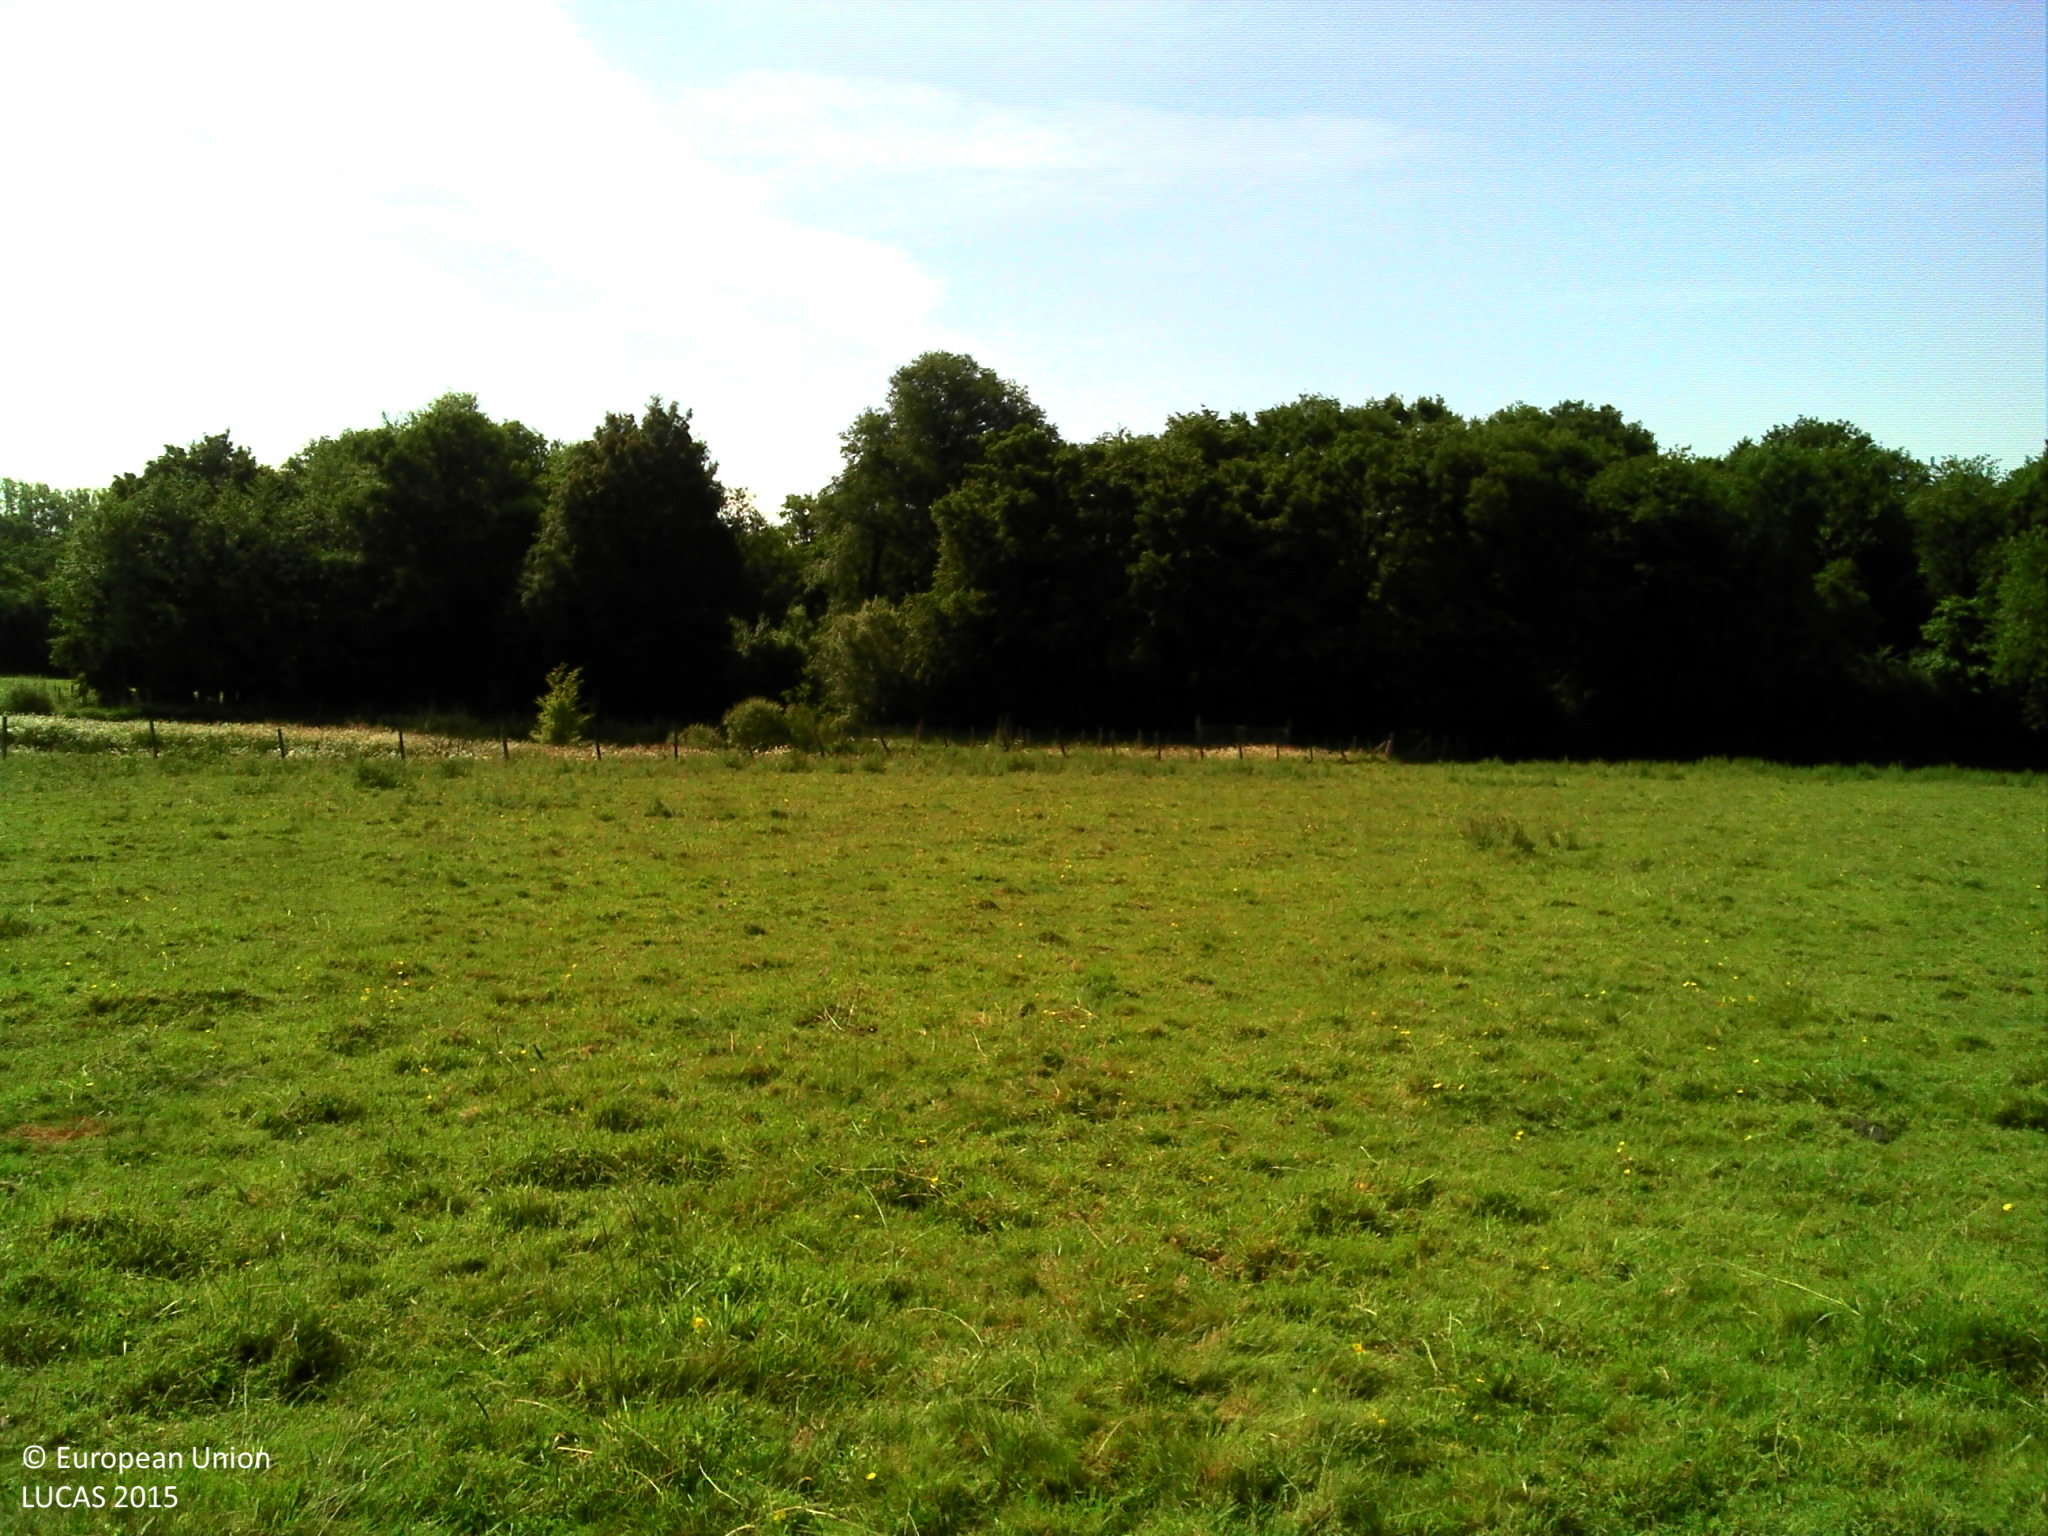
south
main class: Grassland
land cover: Grassland without tree/shrub cover
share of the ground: > 75 %
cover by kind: herbaceous plants 100 %
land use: Agriculture (excluding fallow land and kitchen gardens)
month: June
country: FR
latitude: 48.2902
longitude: -1.5165
